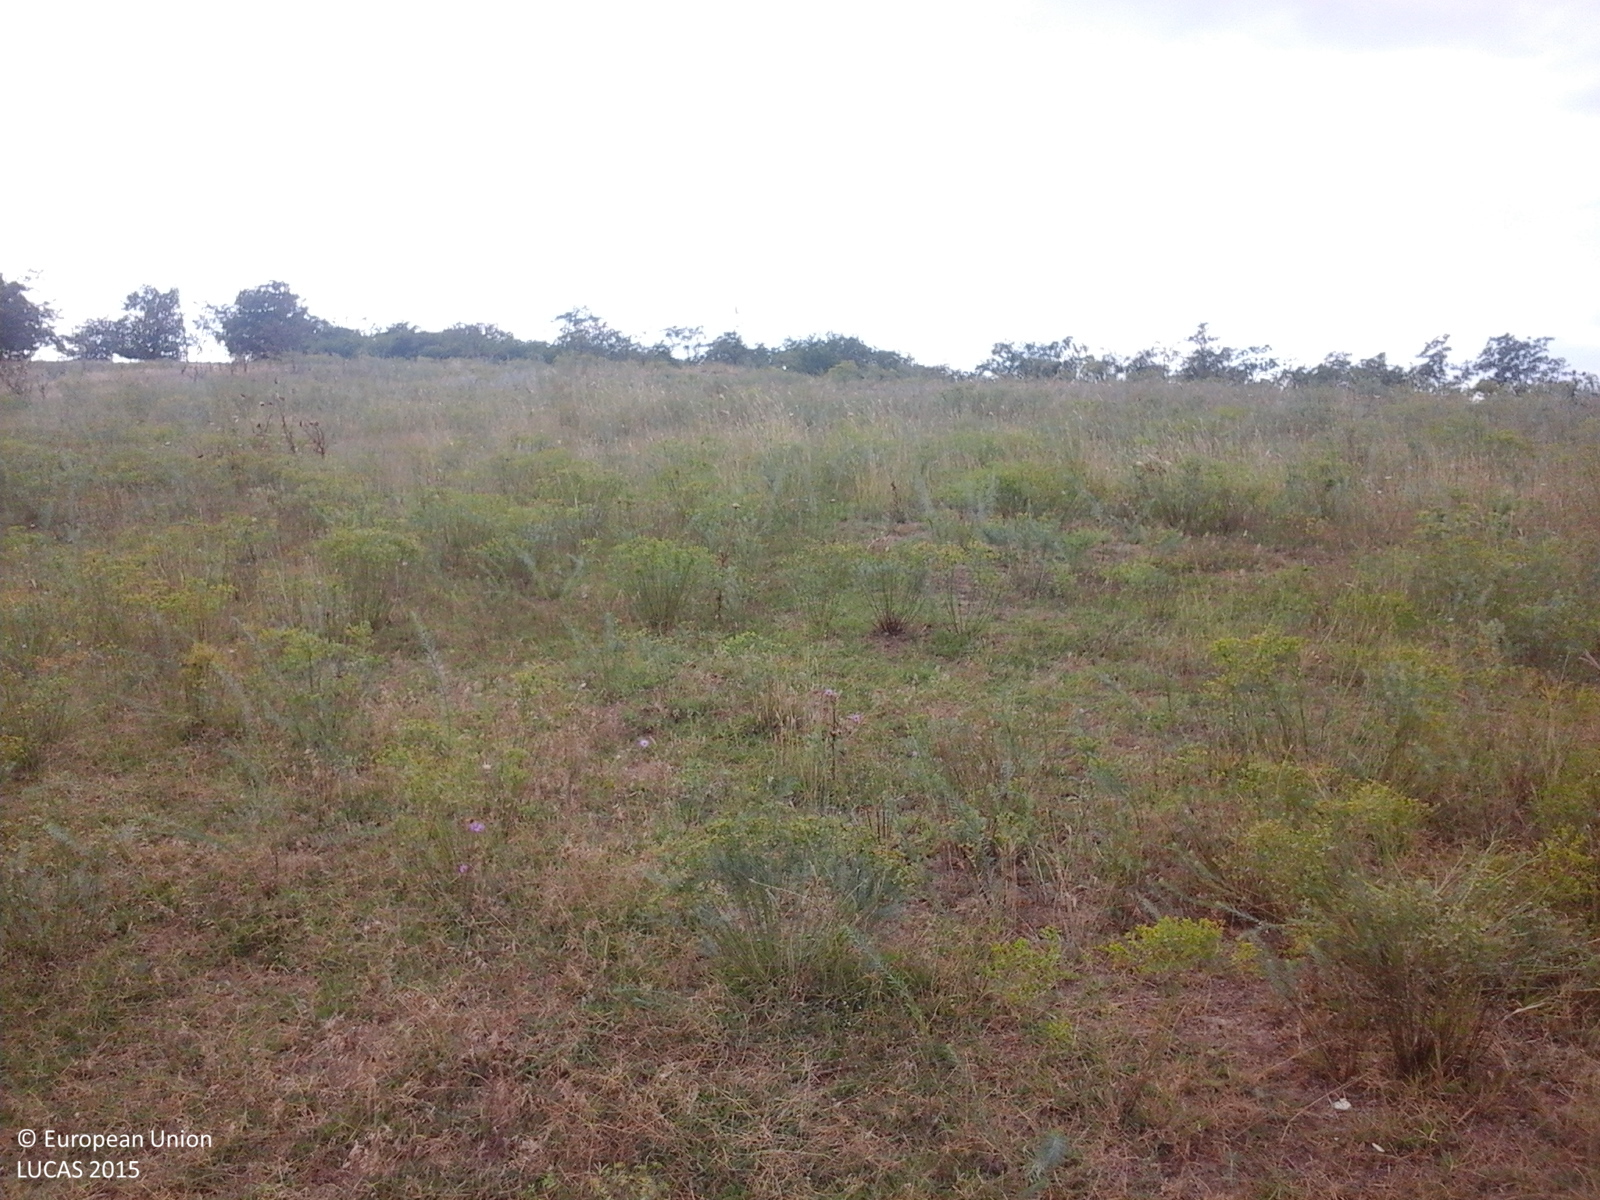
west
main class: Grassland
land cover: Grassland without tree/shrub cover
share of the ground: > 75 %
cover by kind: herbaceous plants 100 %
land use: Agriculture (excluding fallow land and kitchen gardens)
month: August
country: RO
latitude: 44.7118
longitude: 28.1264
